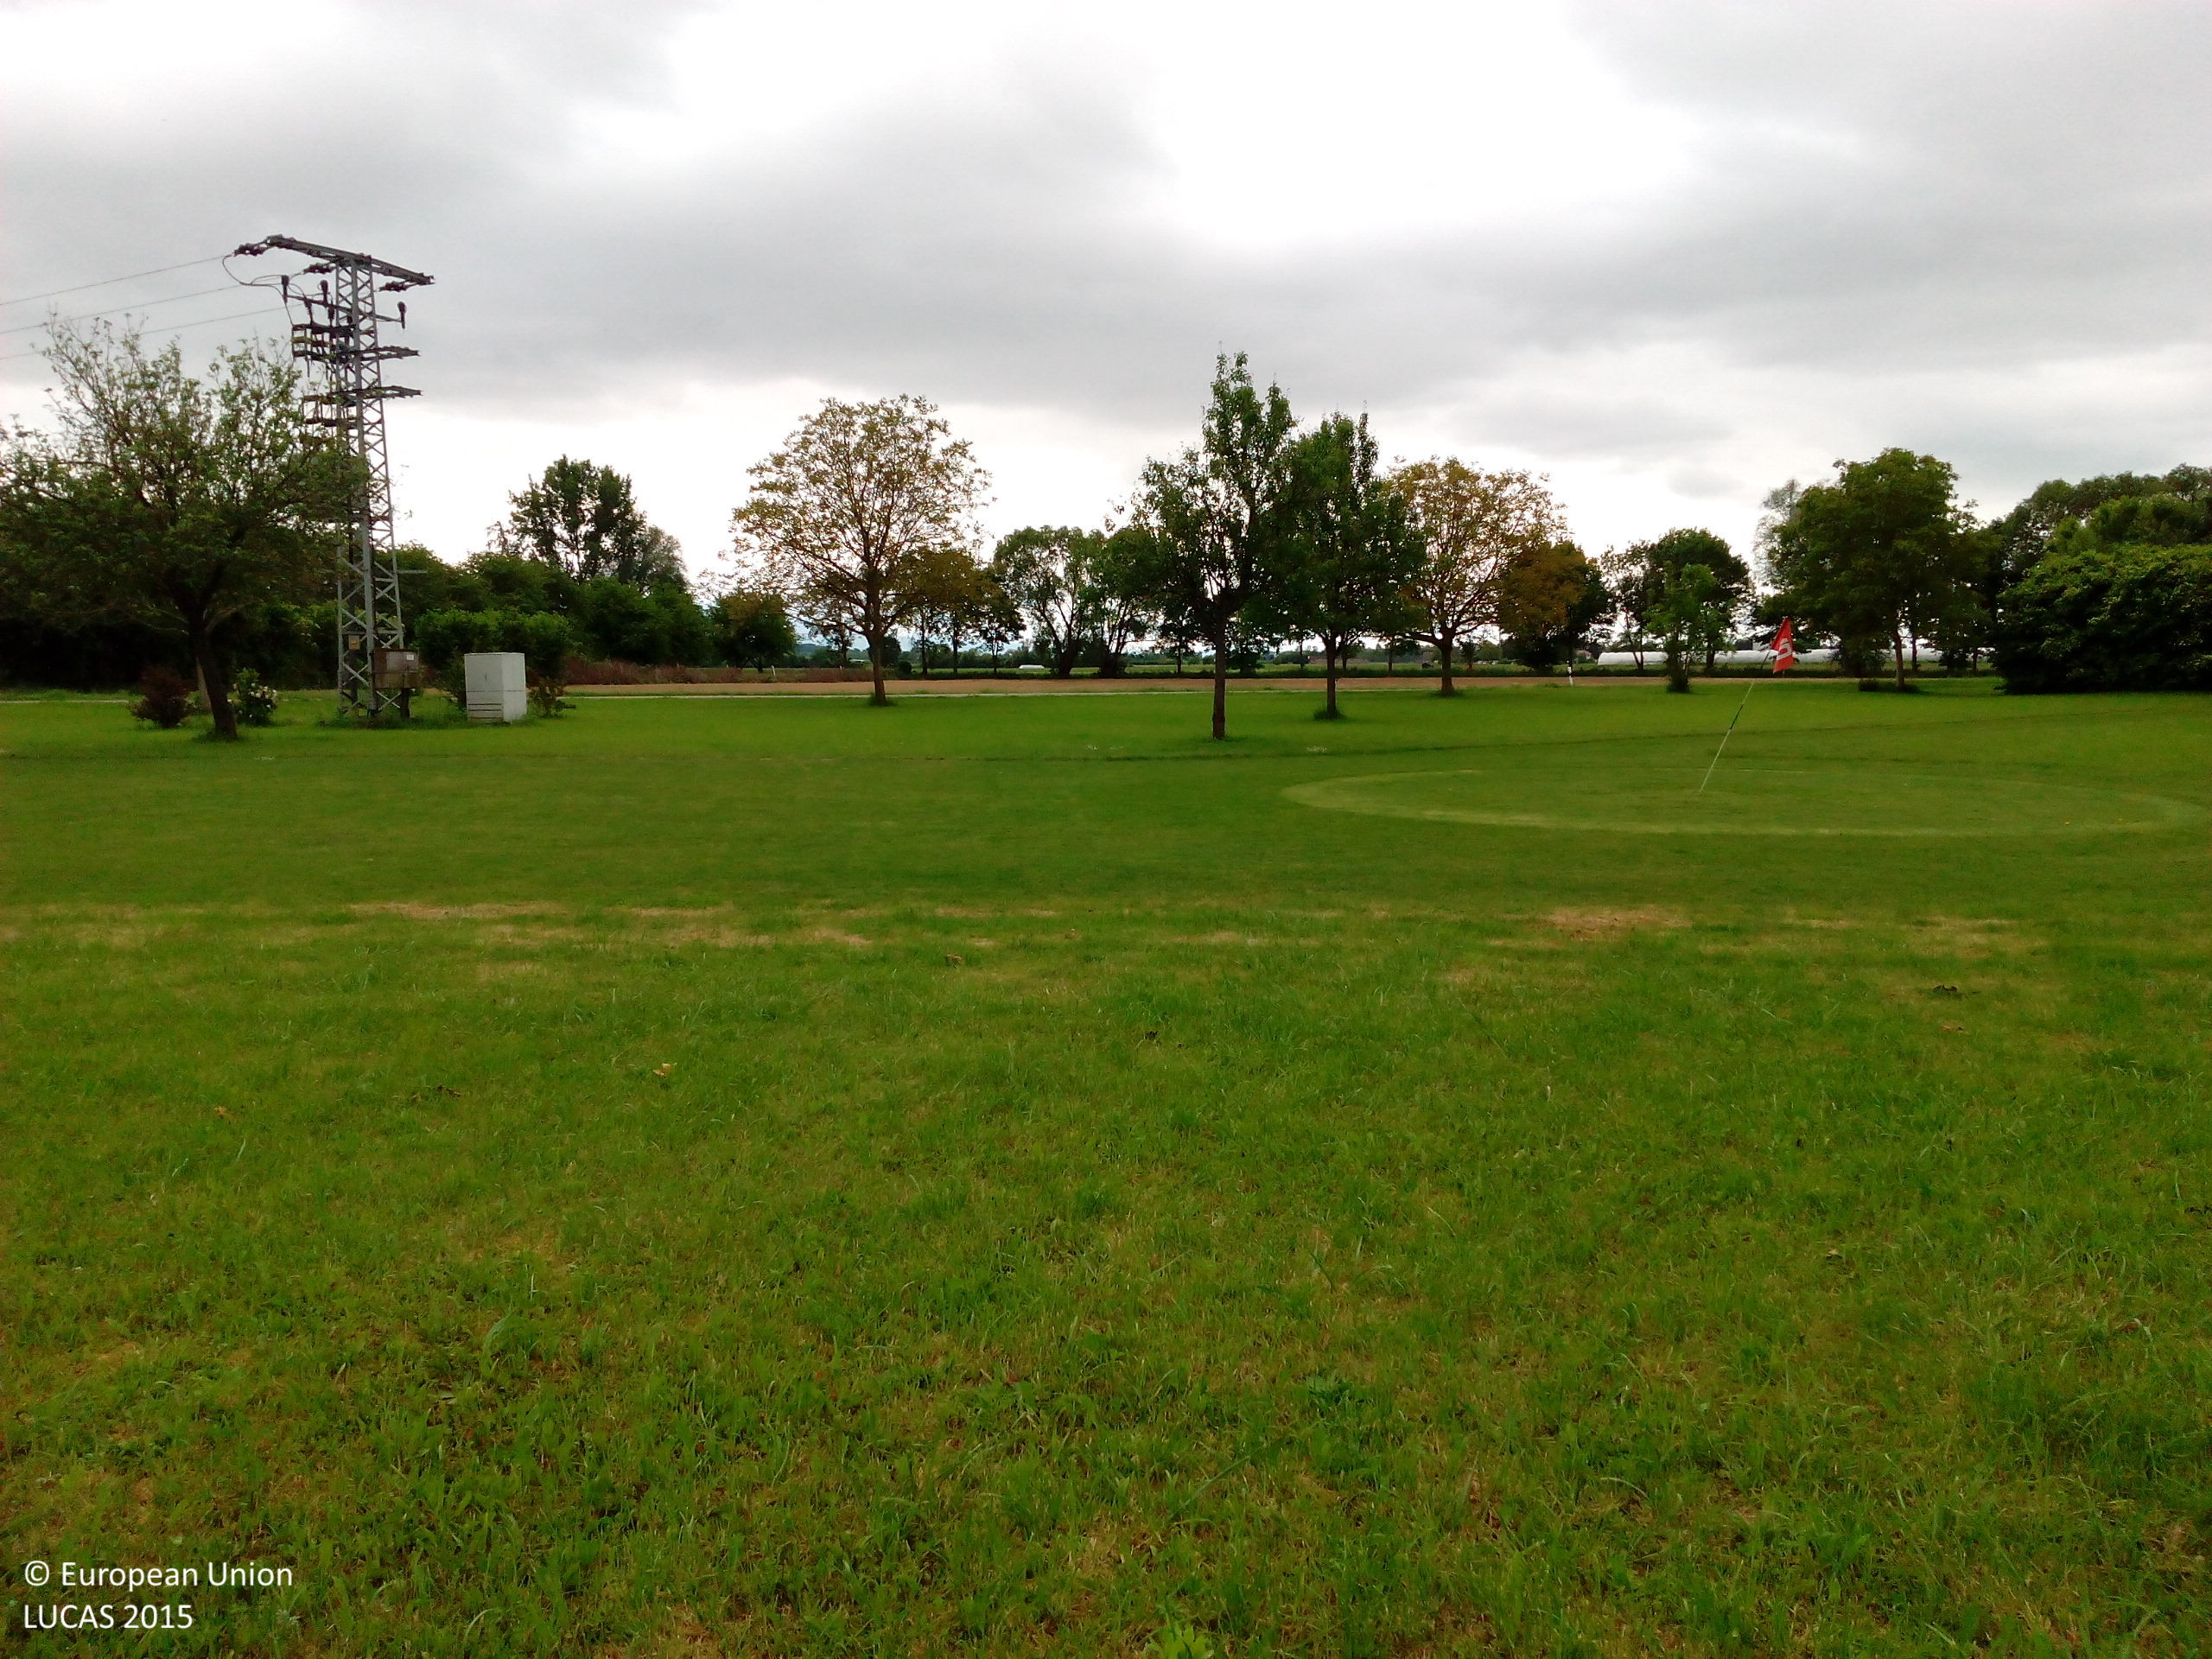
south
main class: Grassland
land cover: Grassland without tree/shrub cover
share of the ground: > 75 %
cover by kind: herbaceous plants 100 %
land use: Sport
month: May
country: DE
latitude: 47.9652
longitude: 7.6841
